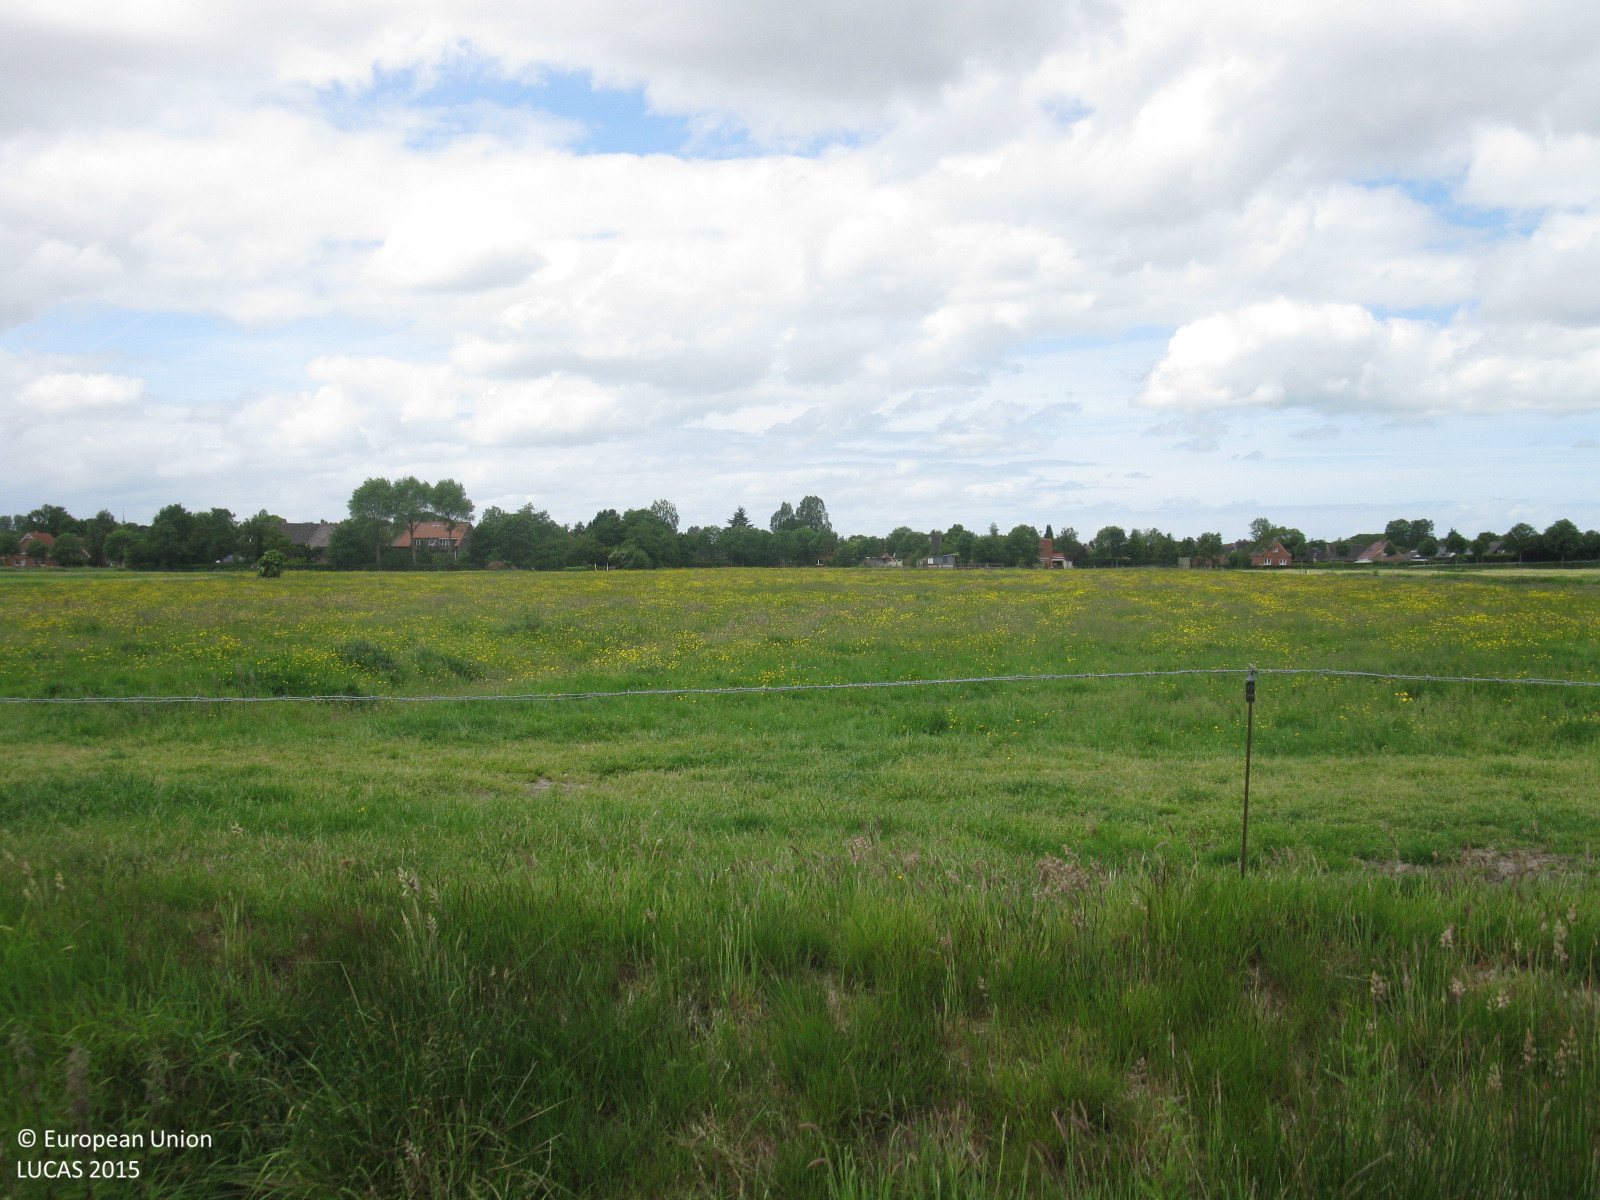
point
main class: Grassland
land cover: Grassland without tree/shrub cover
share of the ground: > 75 %
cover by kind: herbaceous plants 100 %
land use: Agriculture (excluding fallow land and kitchen gardens)
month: June
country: DE
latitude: 53.3355
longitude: 7.2824
